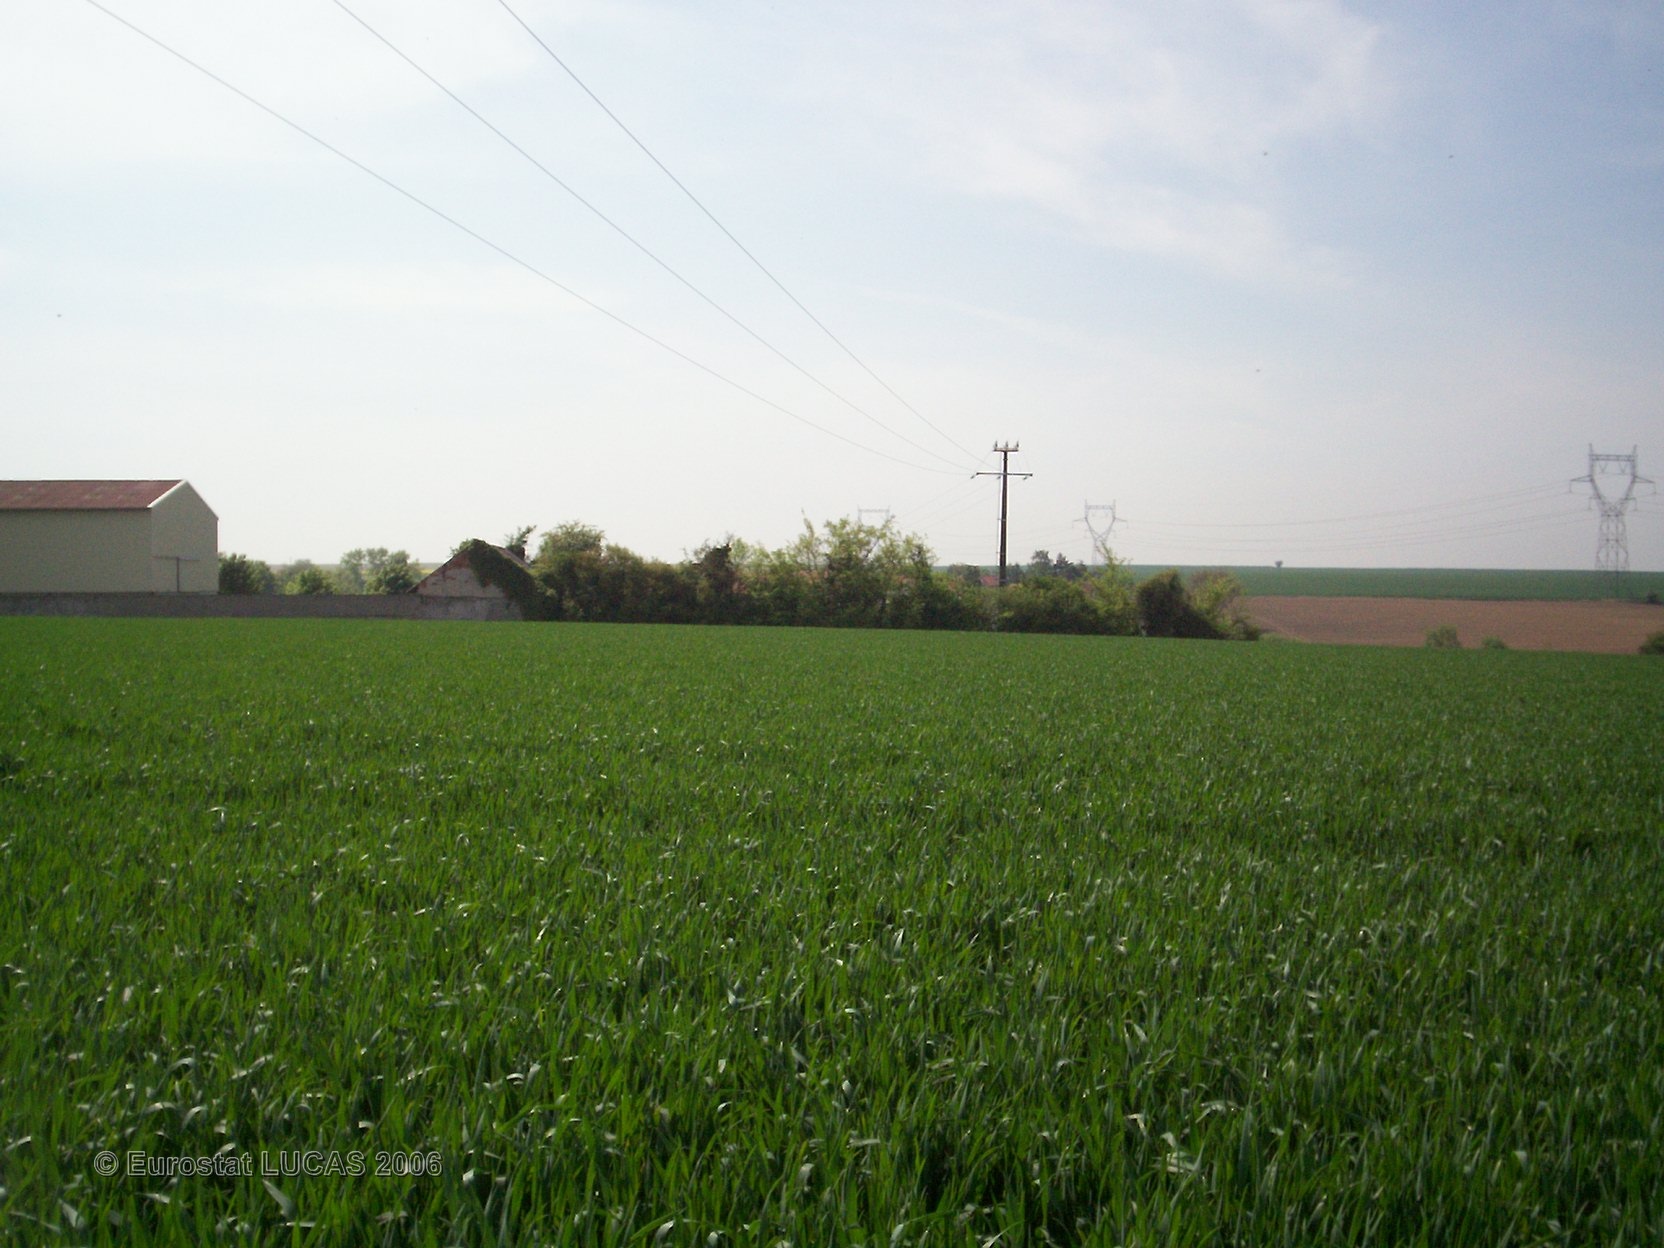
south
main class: Cropland
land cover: Common wheat
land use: Agriculture (excluding fallow land and kitchen gardens)
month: May
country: FR
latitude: 49.0130
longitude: 2.7297
